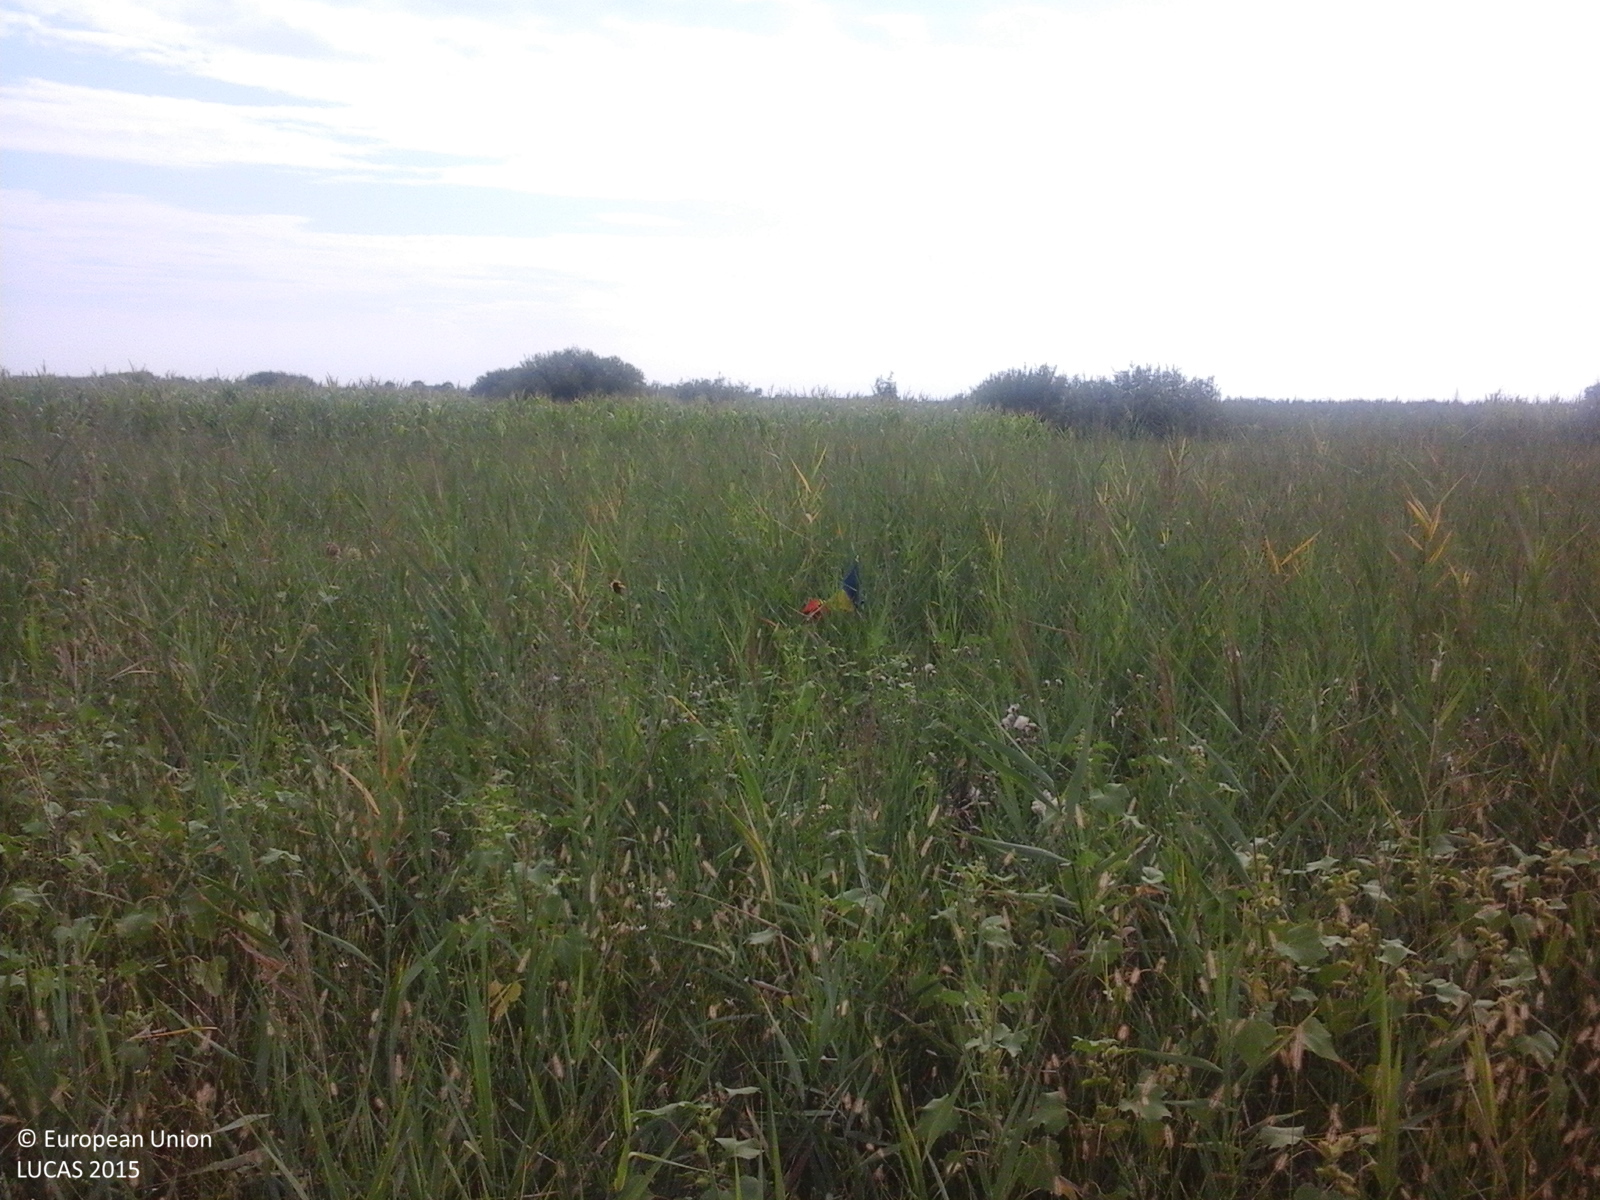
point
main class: Grassland
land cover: Spontaneously vegetated surfaces
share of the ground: > 75 %
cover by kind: herbaceous plants 100 %
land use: Agriculture (excluding fallow land and kitchen gardens)
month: August
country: RO
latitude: 46.5514
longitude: 21.7931
